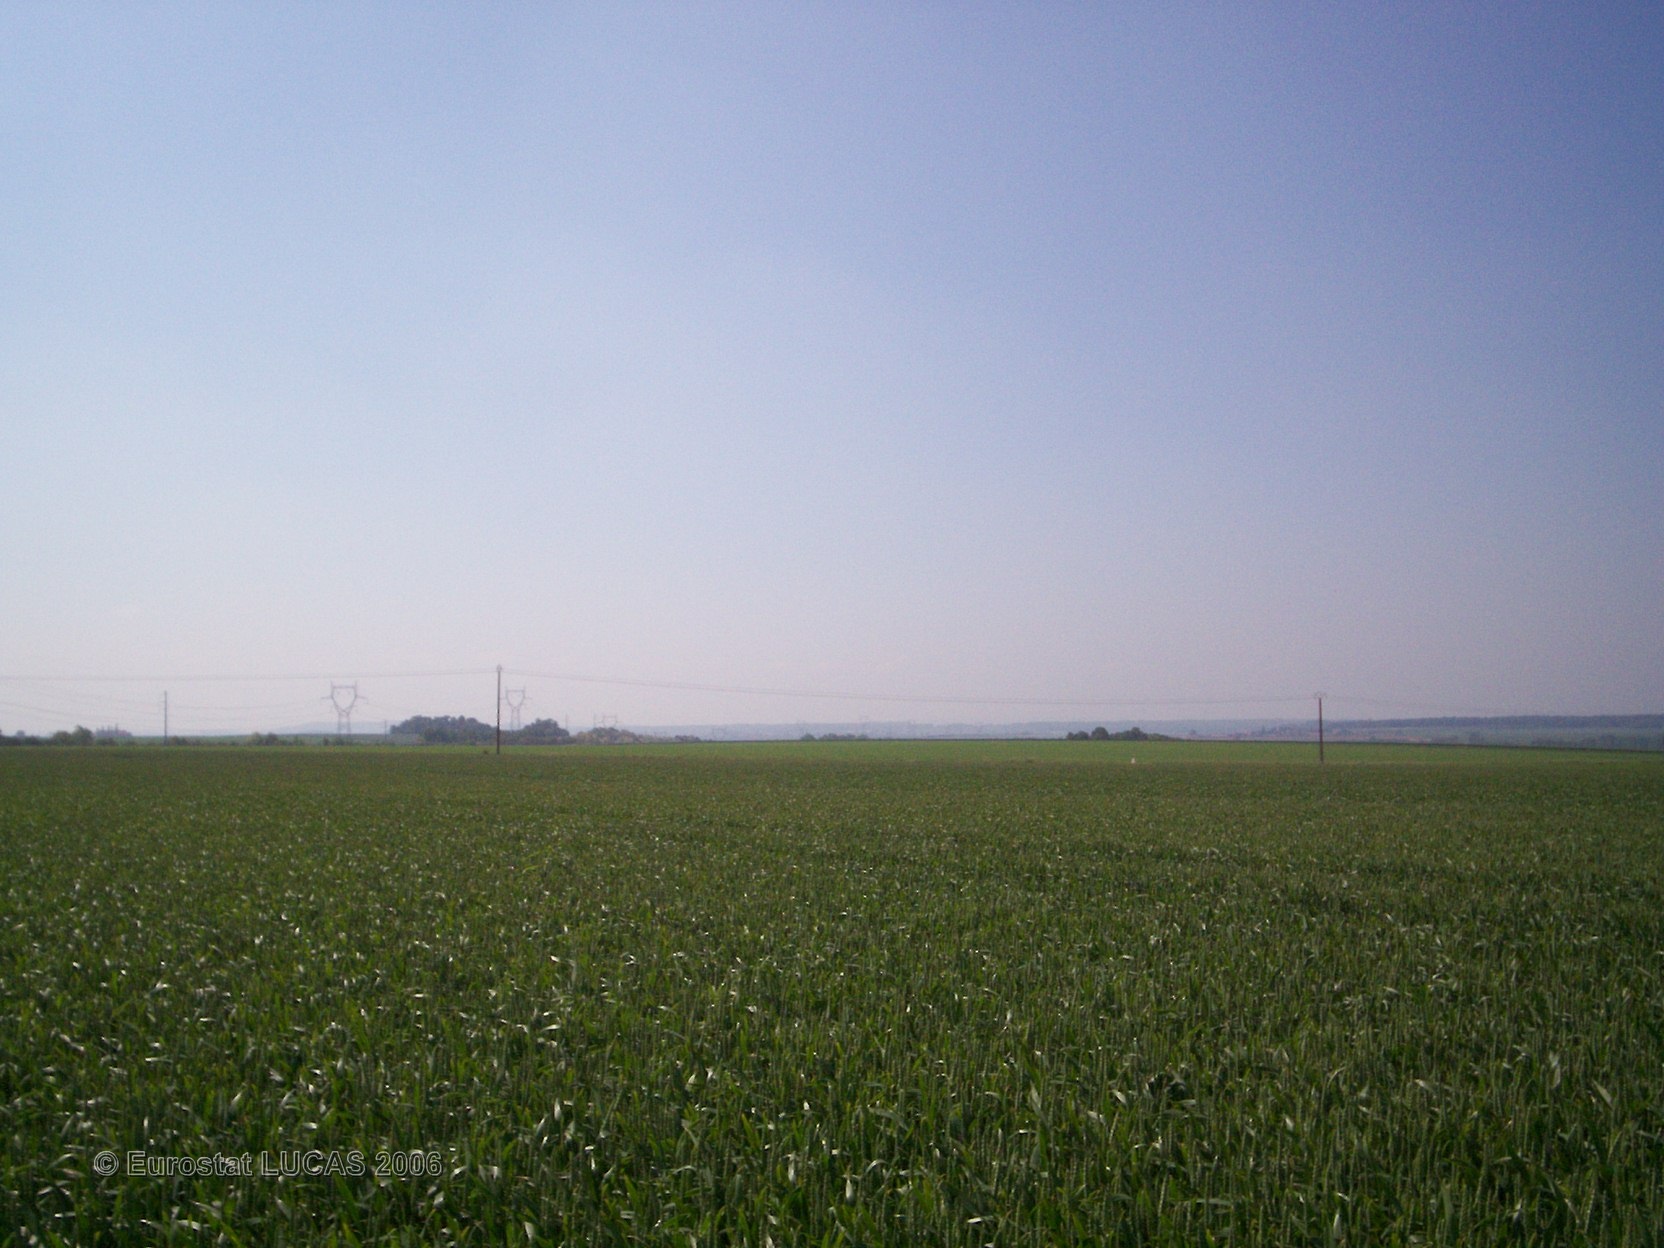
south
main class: Cropland
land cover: Common wheat
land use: Agriculture (excluding fallow land and kitchen gardens)
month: June
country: FR
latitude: 49.4995
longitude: 2.7124
